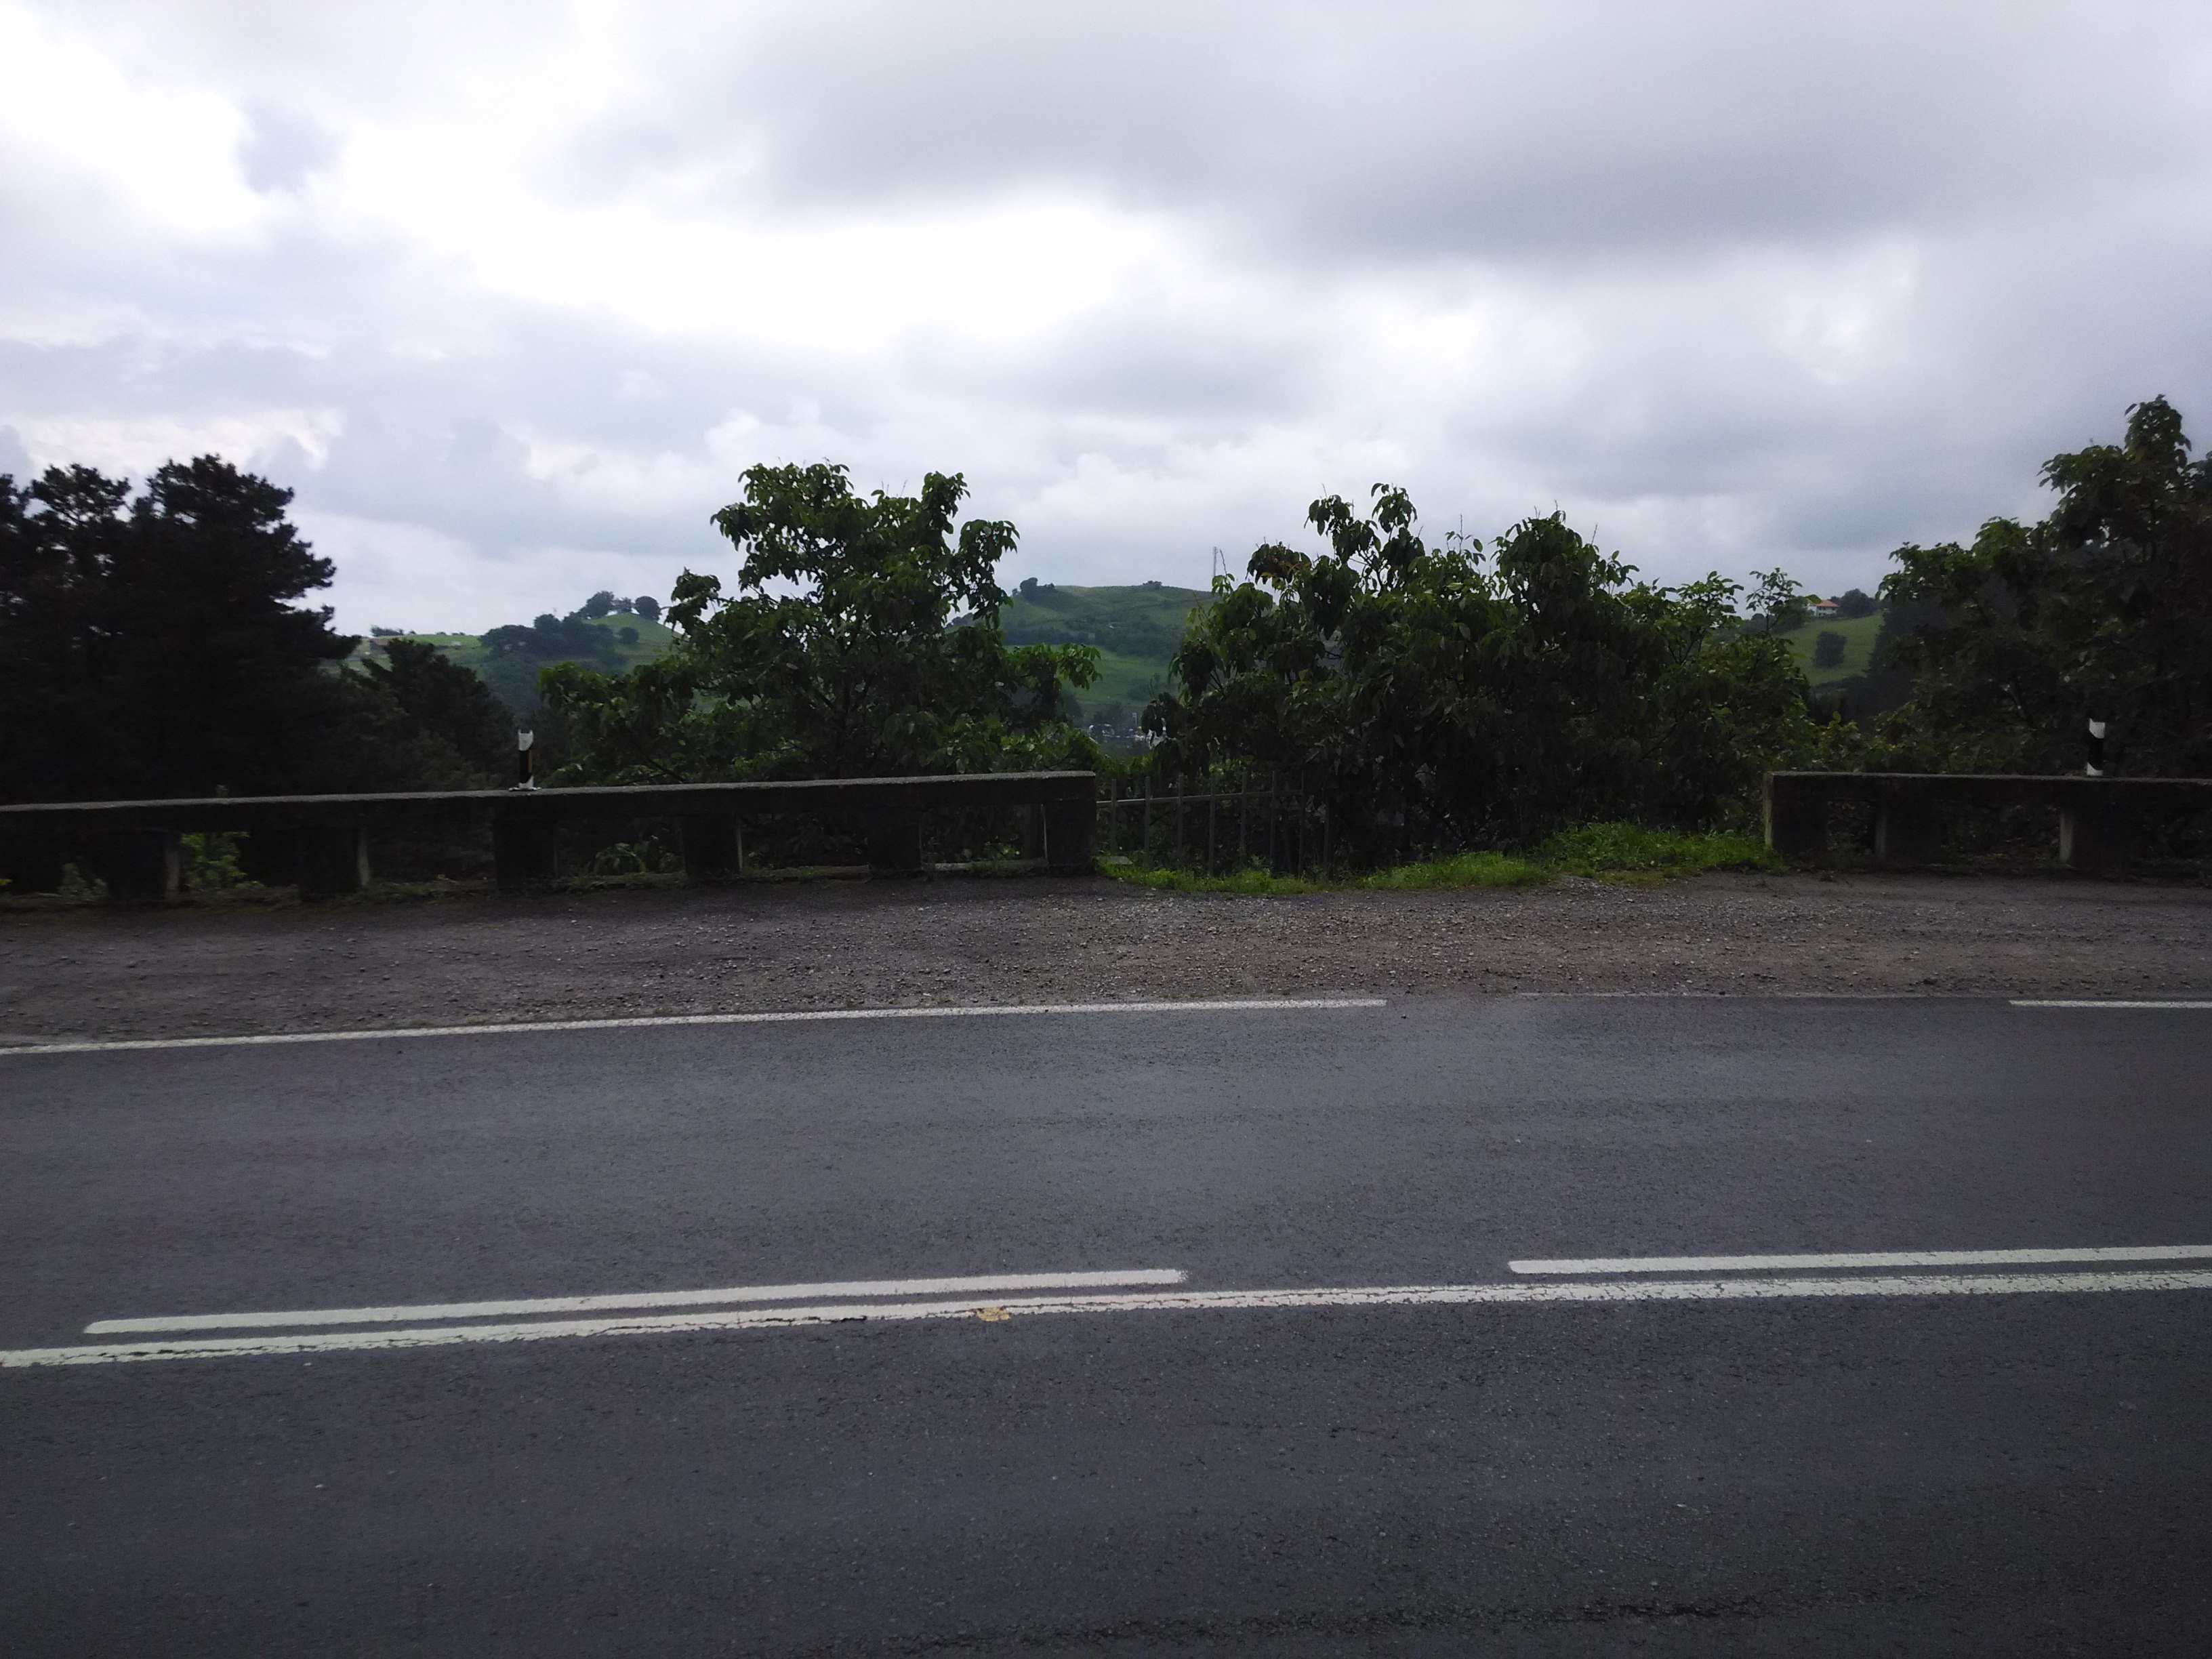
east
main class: Woodland
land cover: Broadleaved woodland
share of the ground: 25 - 50 %
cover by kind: shrubs 40 %, broadleaved forest trees 30 %, consolidated bare surface 30 %
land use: Semi-natural and natural areas not in use
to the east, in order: Broadleaved woodland; Grass margins; Paved roads, cycling and walking lanes; Fences; Nuts trees; Broadleaved woodland; Pine dominated coniferous woodland; Broadleaved woodland
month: June
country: ES
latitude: 43.2830
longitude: -2.3376
